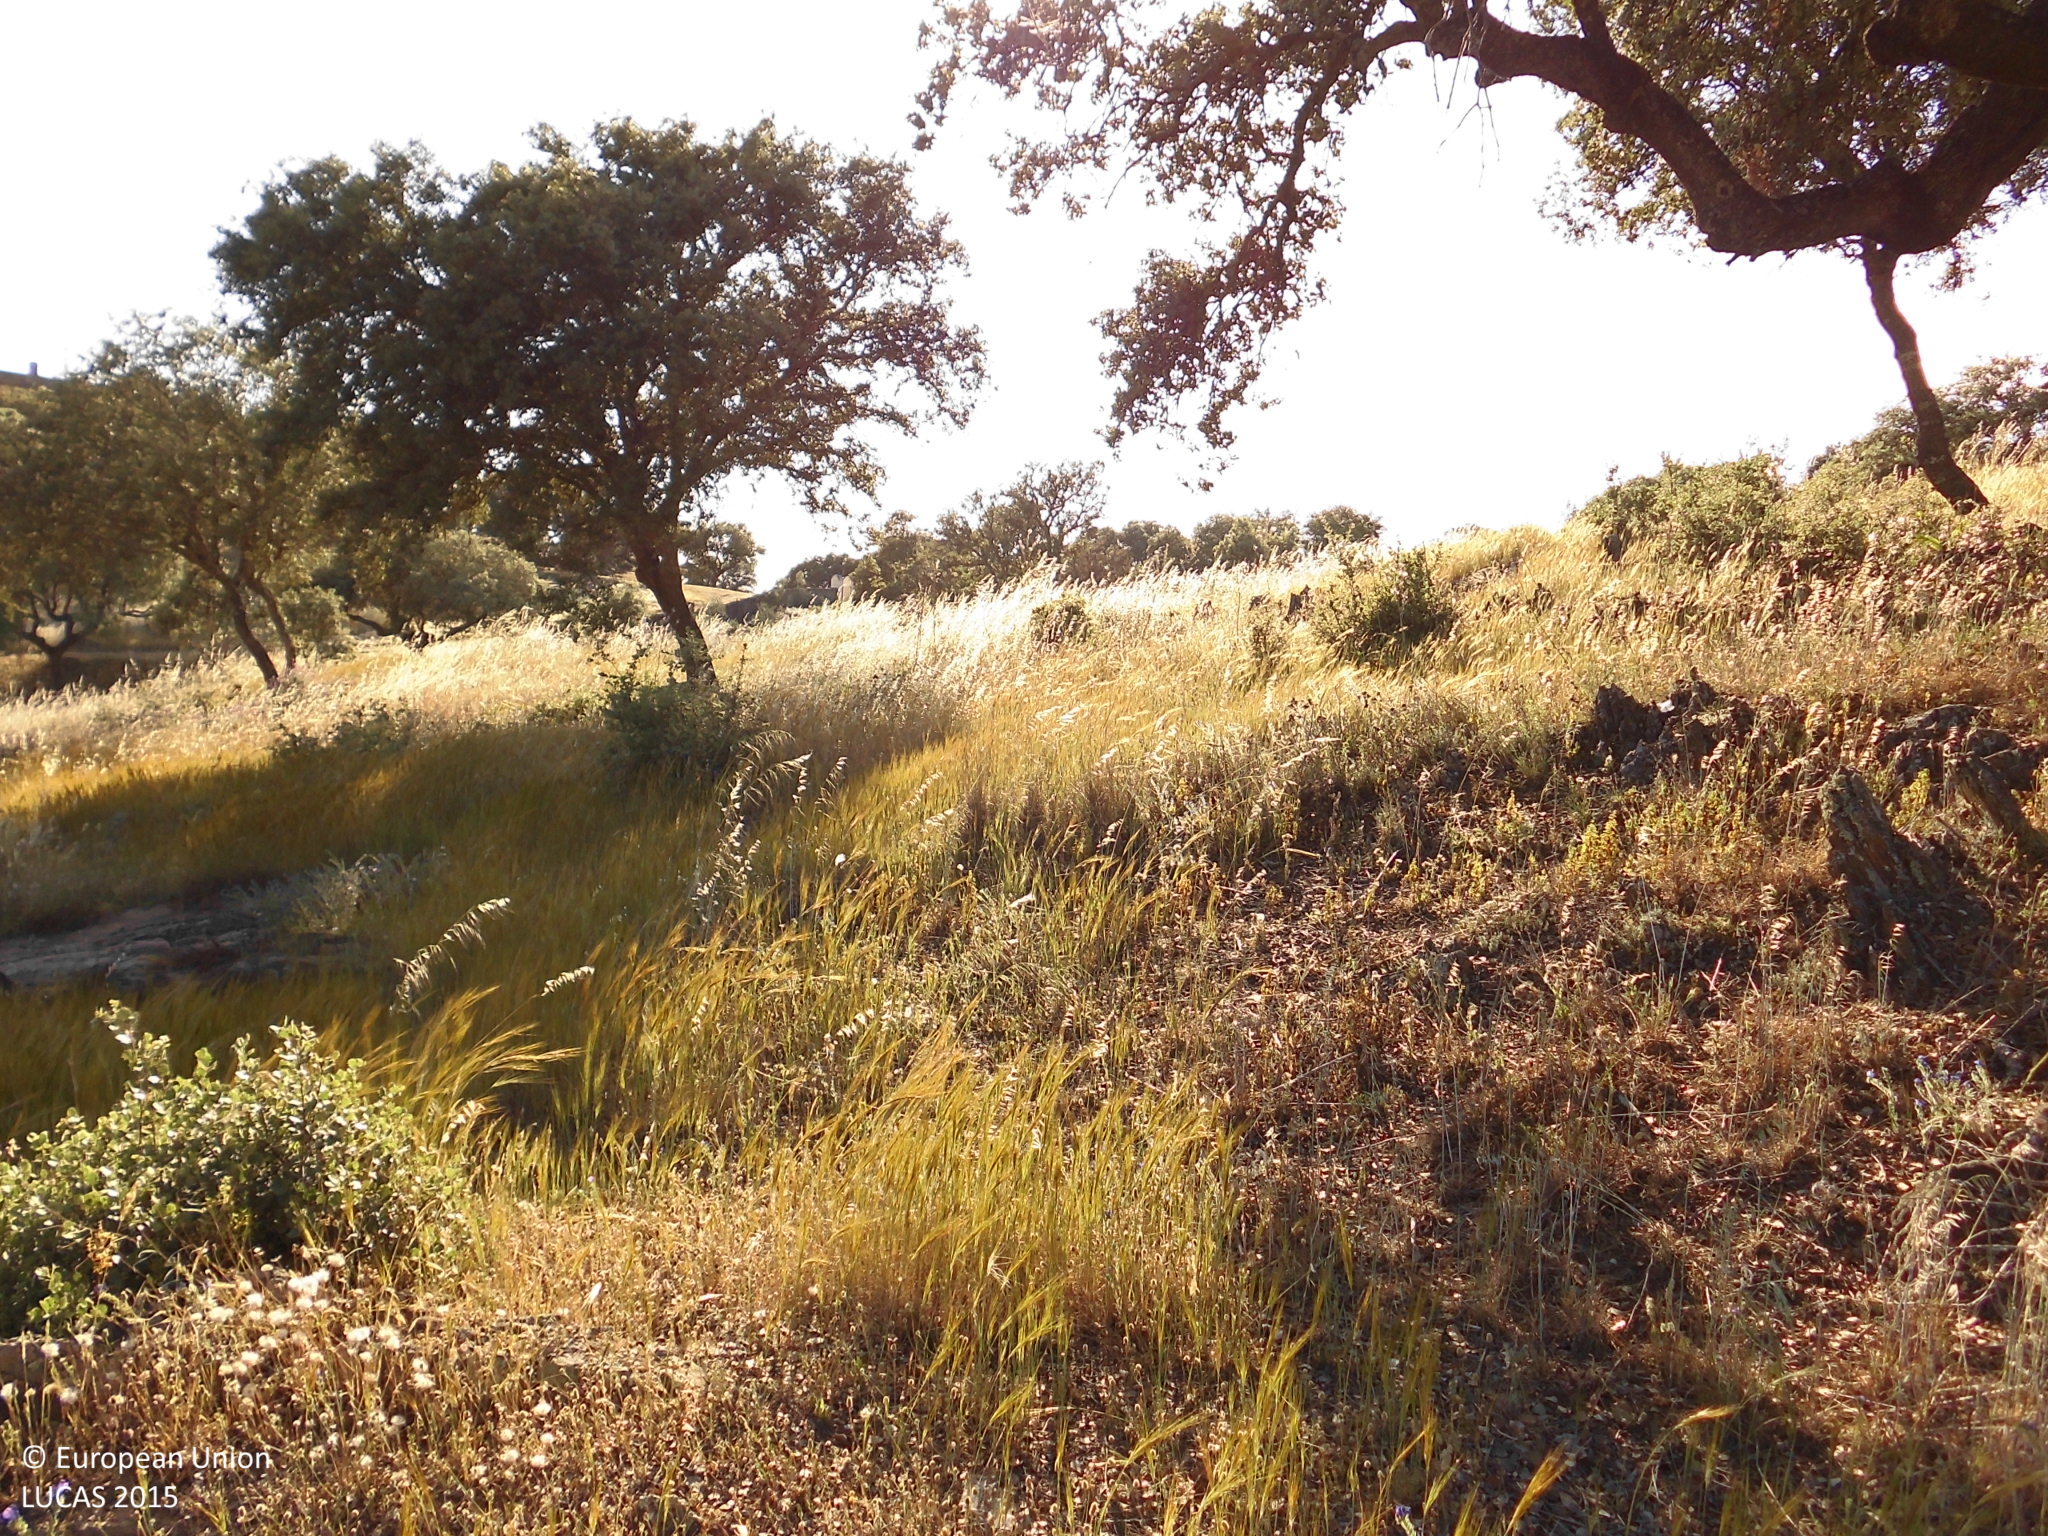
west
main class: Woodland
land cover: Broadleaved woodland
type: broadleaved evergreen forest
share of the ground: 10 - 25 %
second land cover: Grassland without tree/shrub cover
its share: > 75 %
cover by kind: herbaceous plants 70 %, broadleaved forest trees 25 %, shrubs 5 %
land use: Forestry
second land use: Agriculture (excluding fallow land and kitchen gardens)
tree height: > 5 m
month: May
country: ES
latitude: 39.4986
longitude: -6.0989
